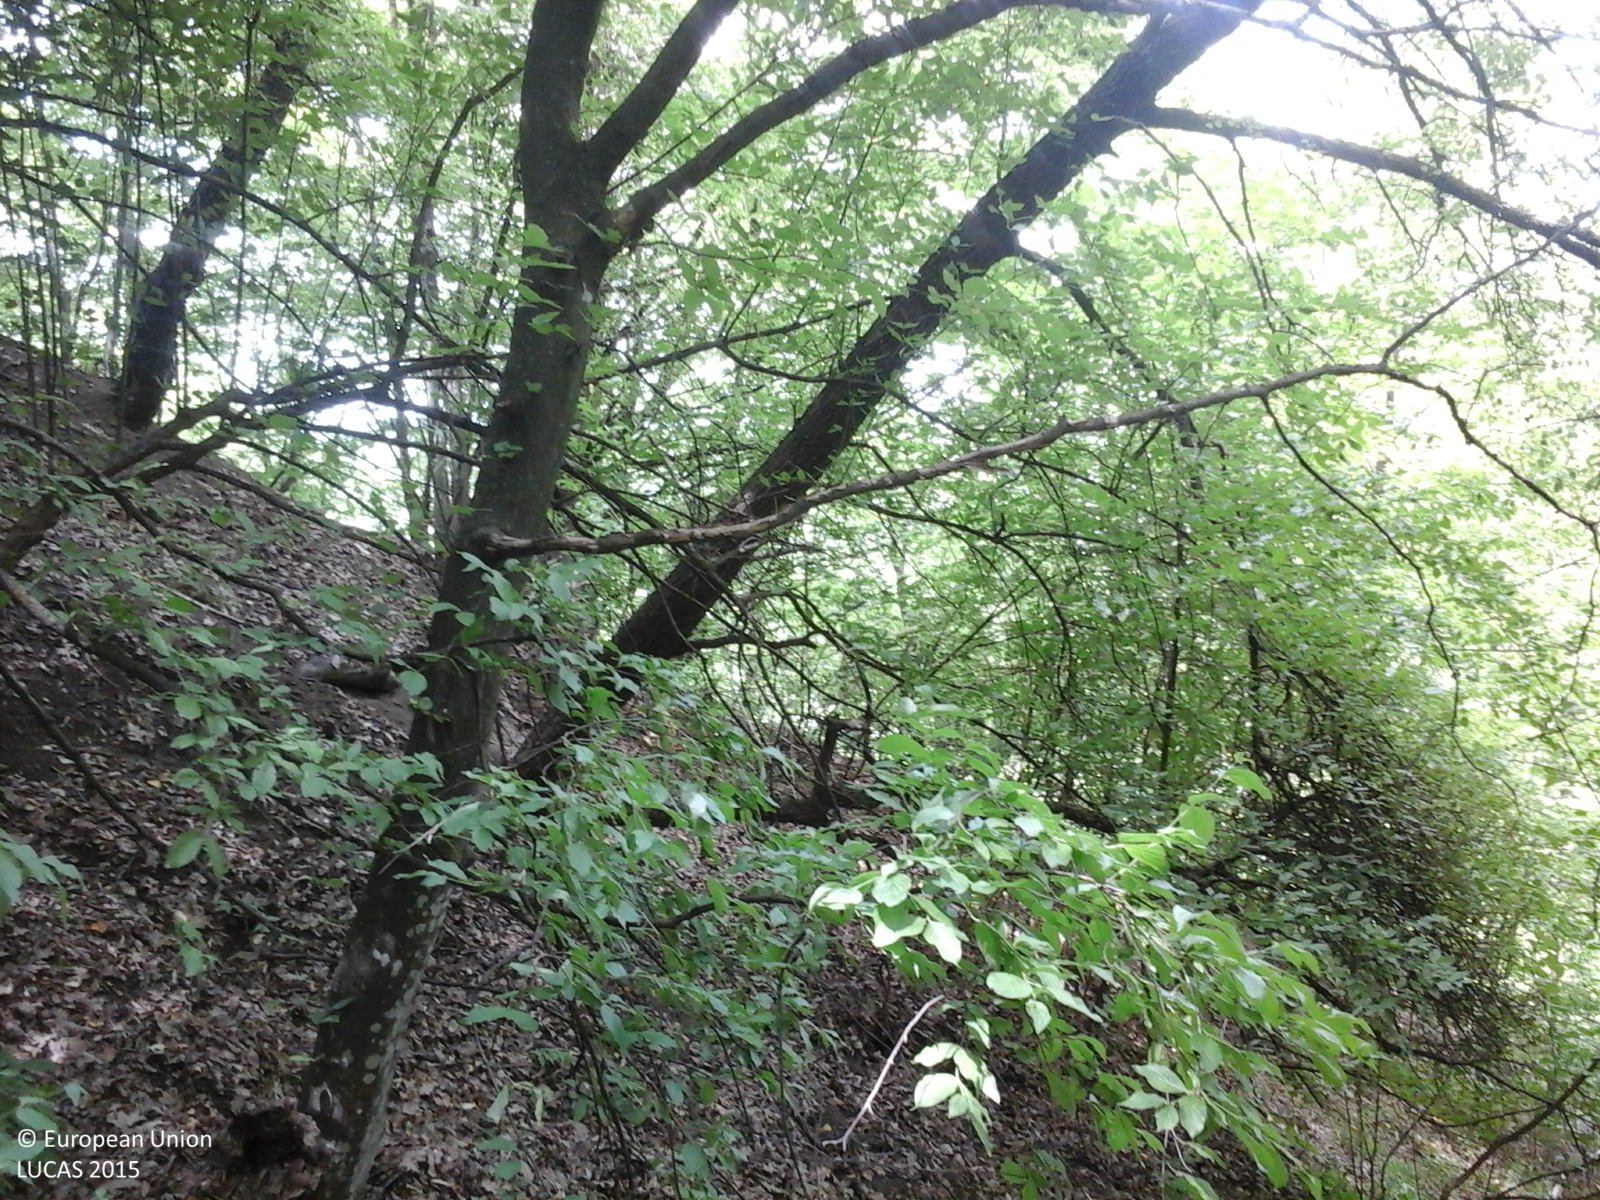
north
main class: Woodland
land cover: Broadleaved woodland
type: beech forest
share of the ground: > 75 %
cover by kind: broadleaved forest trees 95 %, herbaceous plants 5 %
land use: Forestry
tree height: > 5 m
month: June
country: RO
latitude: 47.8932
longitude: 26.3377
